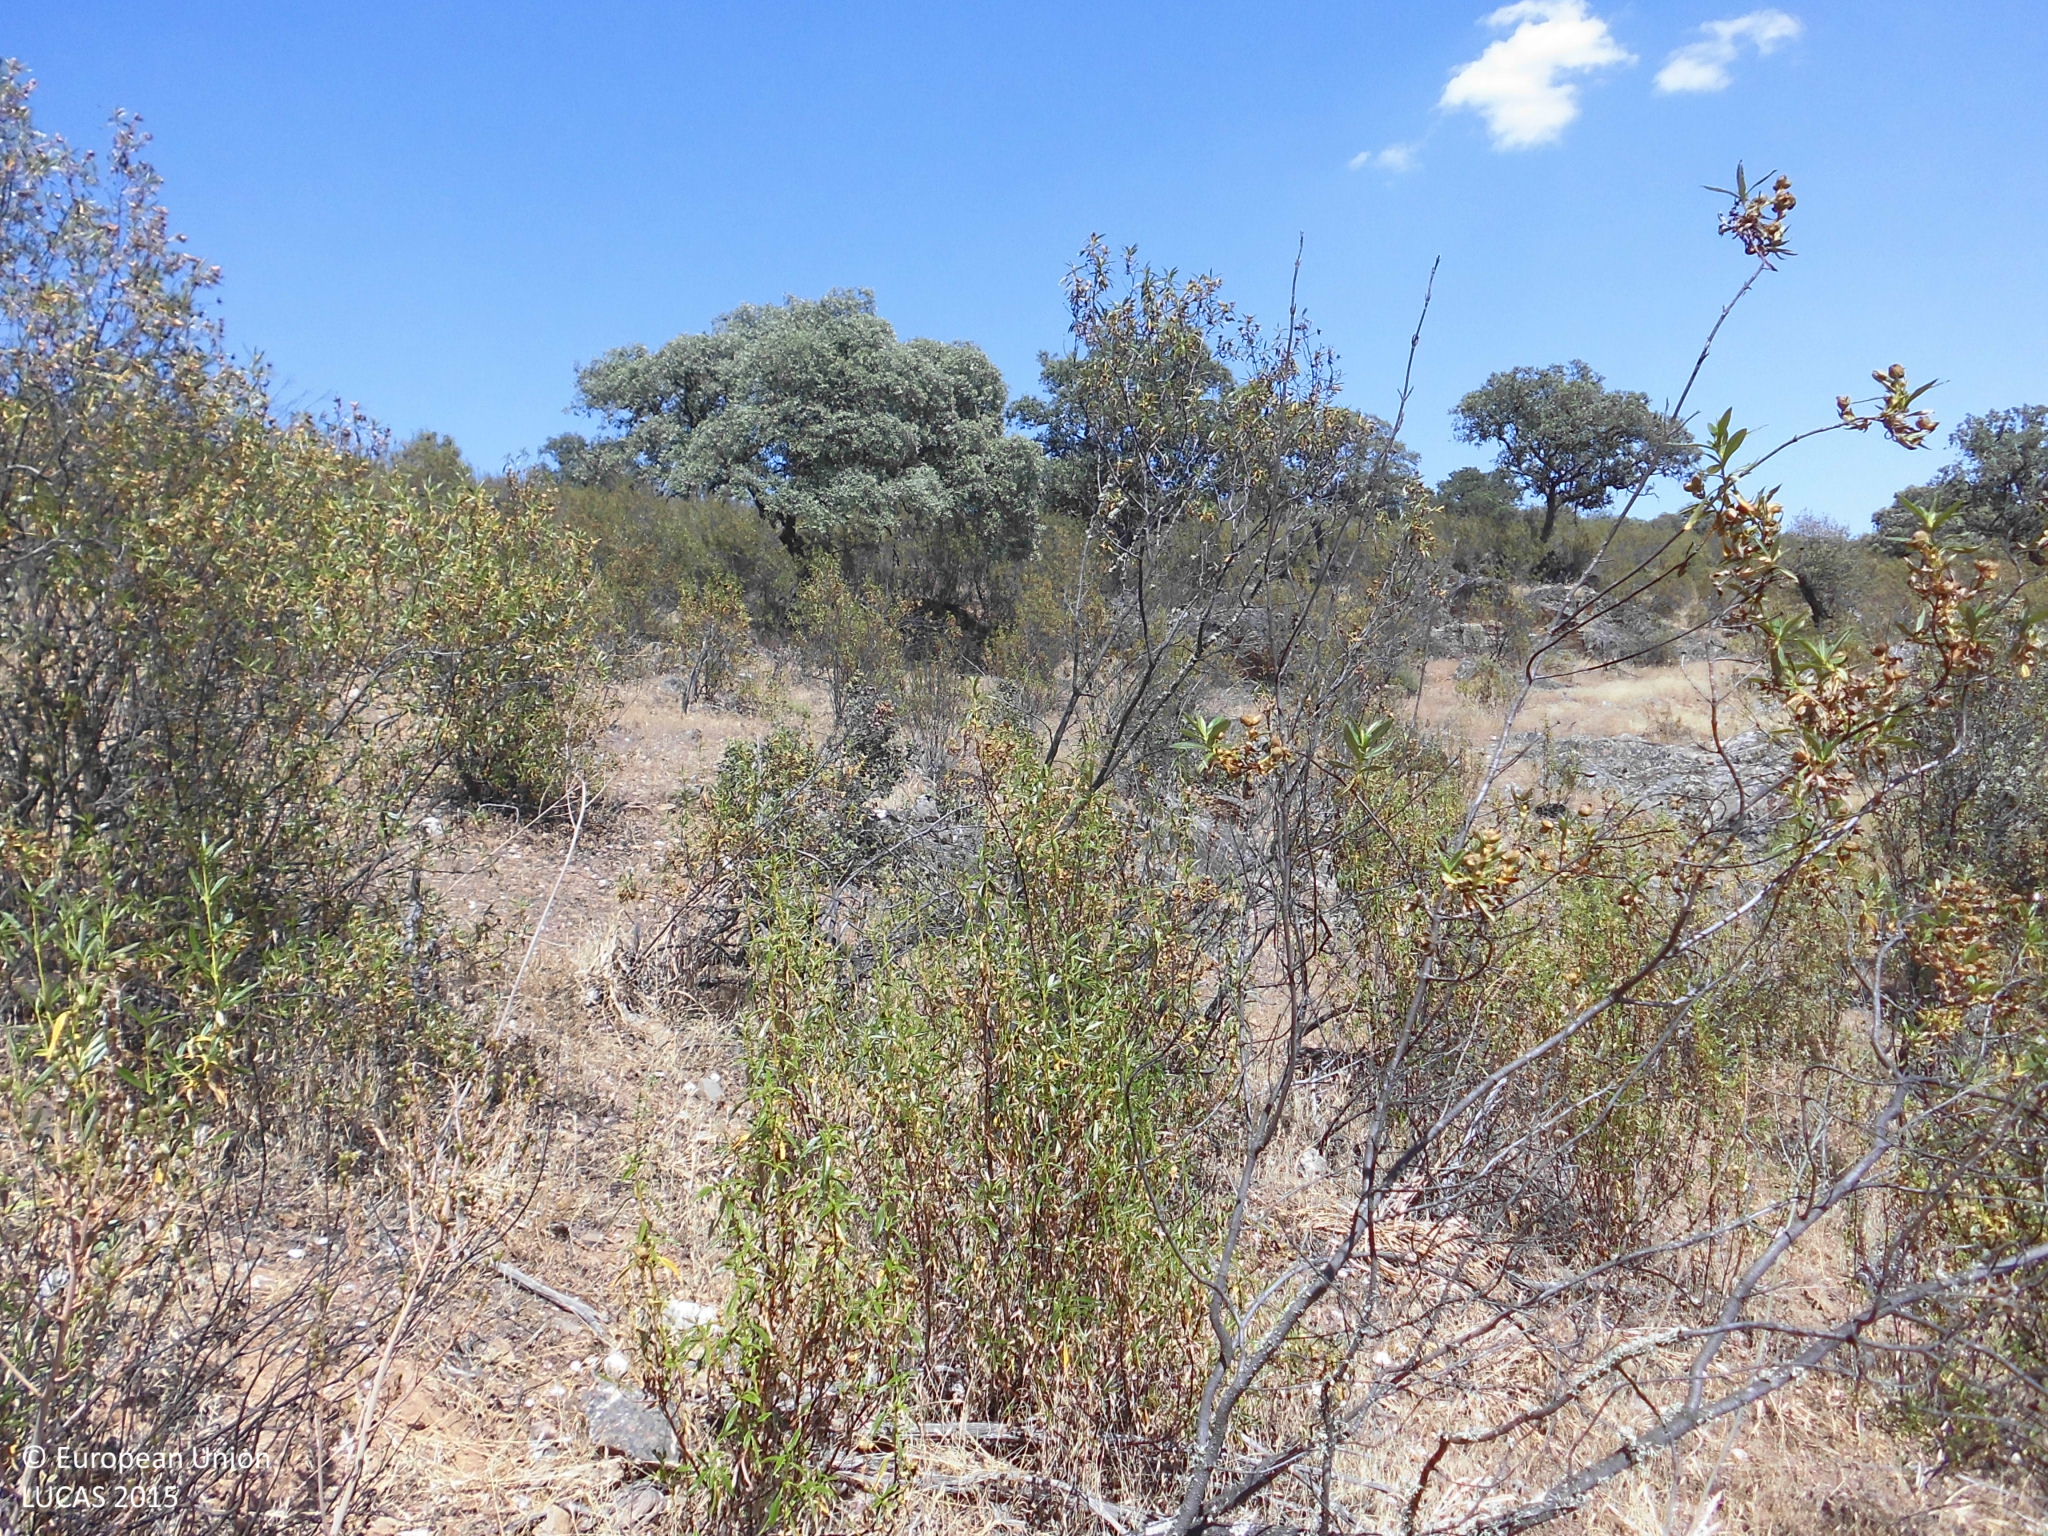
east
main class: Woodland
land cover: Broadleaved woodland
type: broadleaved evergreen forest
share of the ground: 10 - 25 %
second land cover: Shrubland without tree cover
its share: > 75 %
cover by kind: herbaceous plants 60 %, shrubs 25 %, broadleaved forest trees 15 %
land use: Forestry
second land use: Agriculture (excluding fallow land and kitchen gardens)
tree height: > 5 m
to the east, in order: Broadleaved woodland; Shrubland without tree cover; Fences; Broadleaved woodland
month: May
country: ES
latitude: 39.9109
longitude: -6.7053
